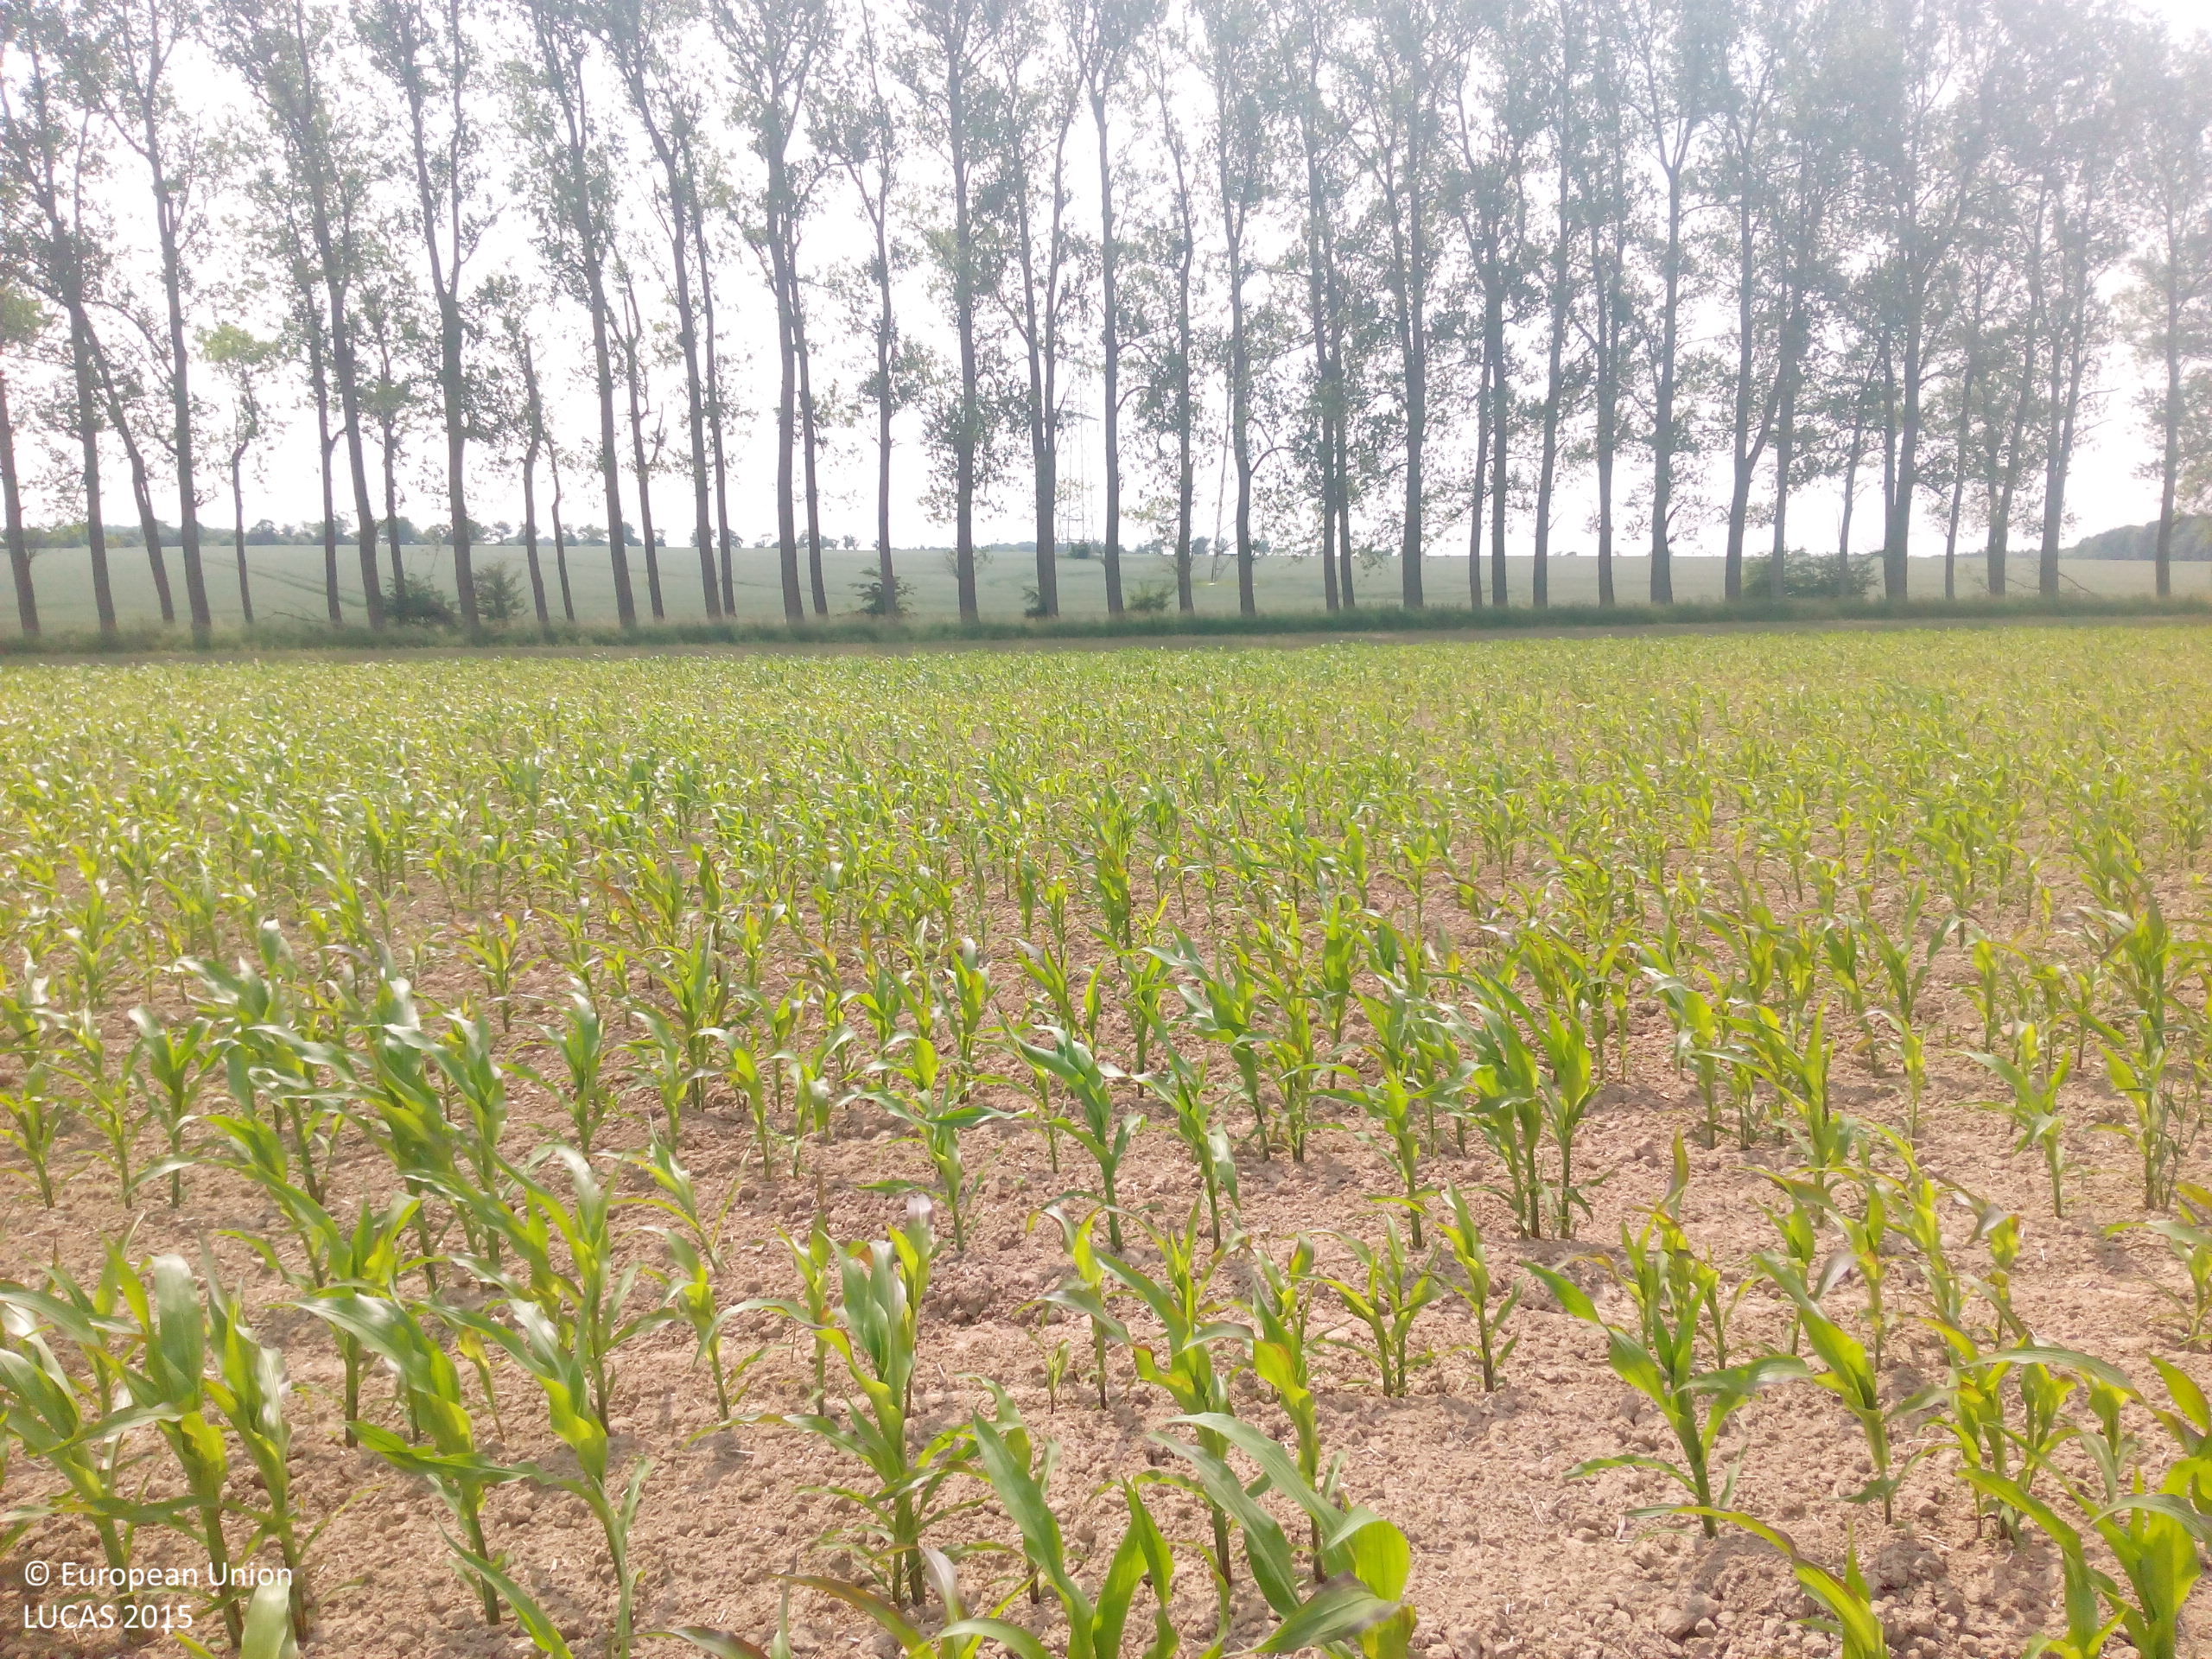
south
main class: Cropland
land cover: Maize
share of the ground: 25 - 50 %
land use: Agriculture (excluding fallow land and kitchen gardens)
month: June
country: DE
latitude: 52.1744
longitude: 11.1256
